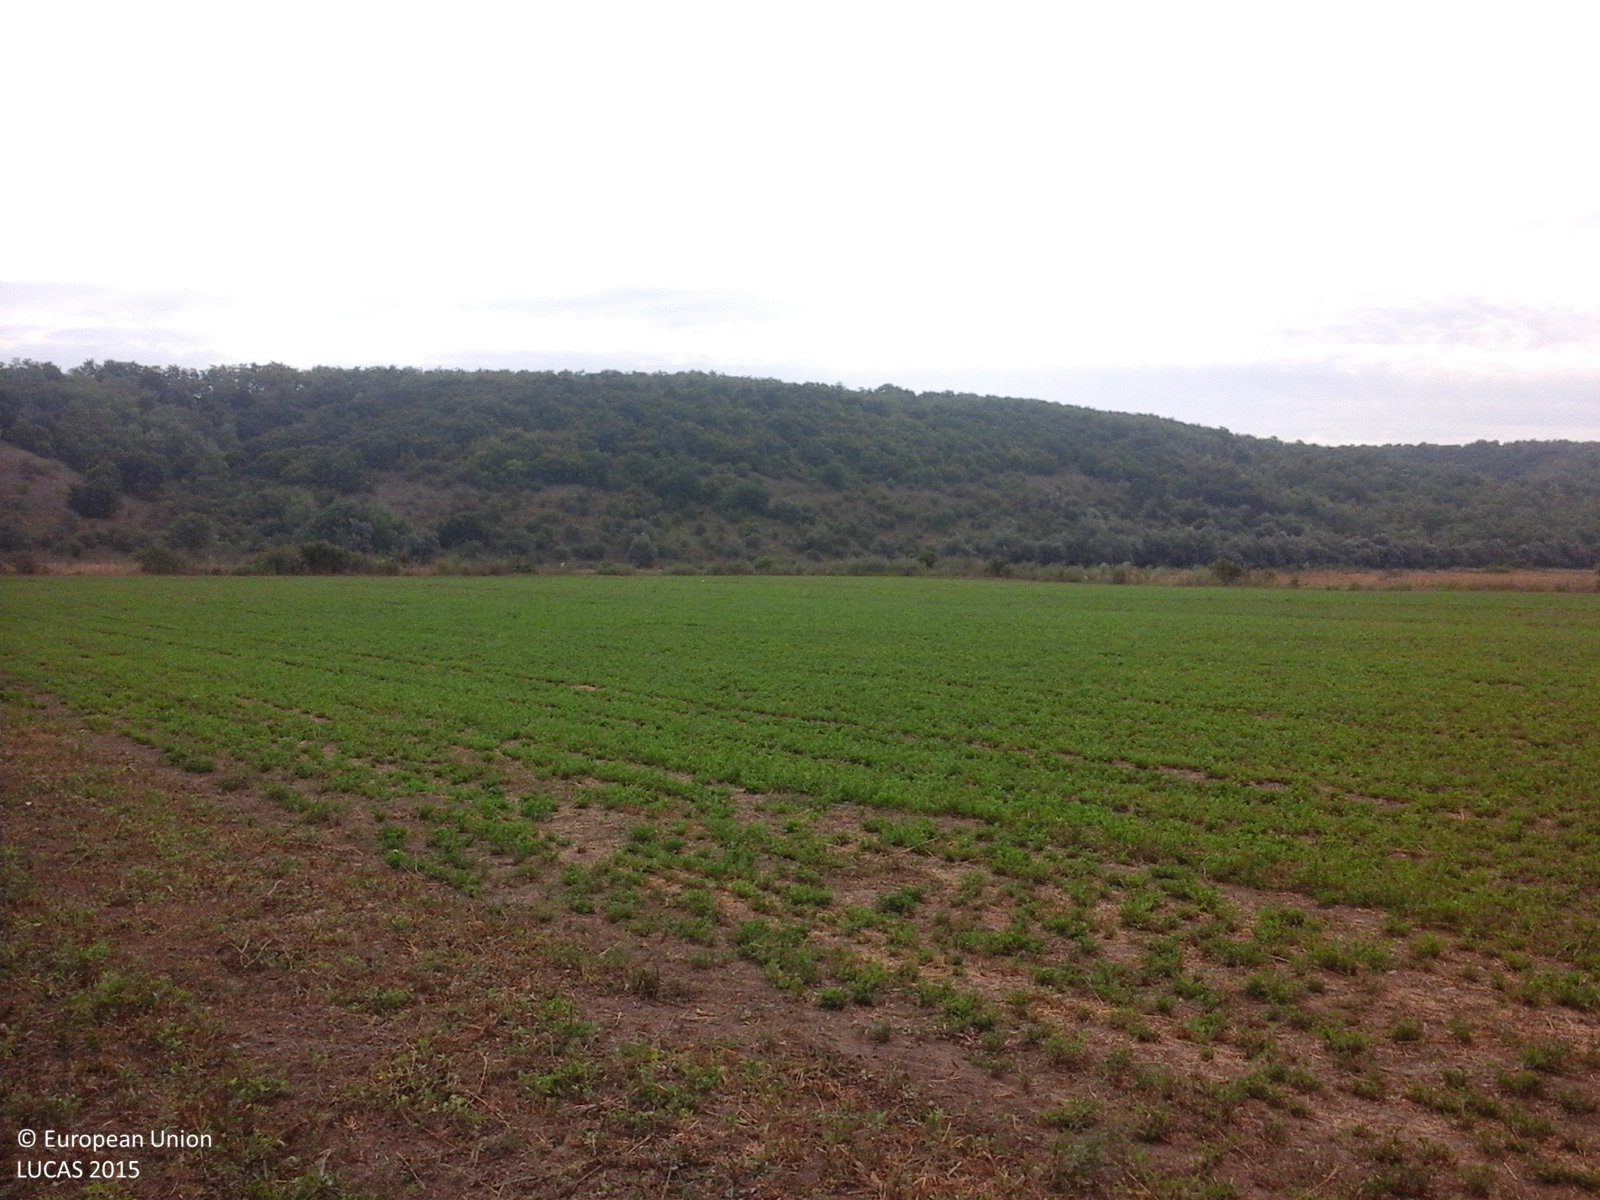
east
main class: Cropland
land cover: Lucerne
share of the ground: 10 - 25 %
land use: Agriculture (excluding fallow land and kitchen gardens)
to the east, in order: Lucerne; Shruby margins; Ditches and canals; Shruby margins; Common wheat
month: August
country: RO
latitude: 44.1231
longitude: 27.9085
